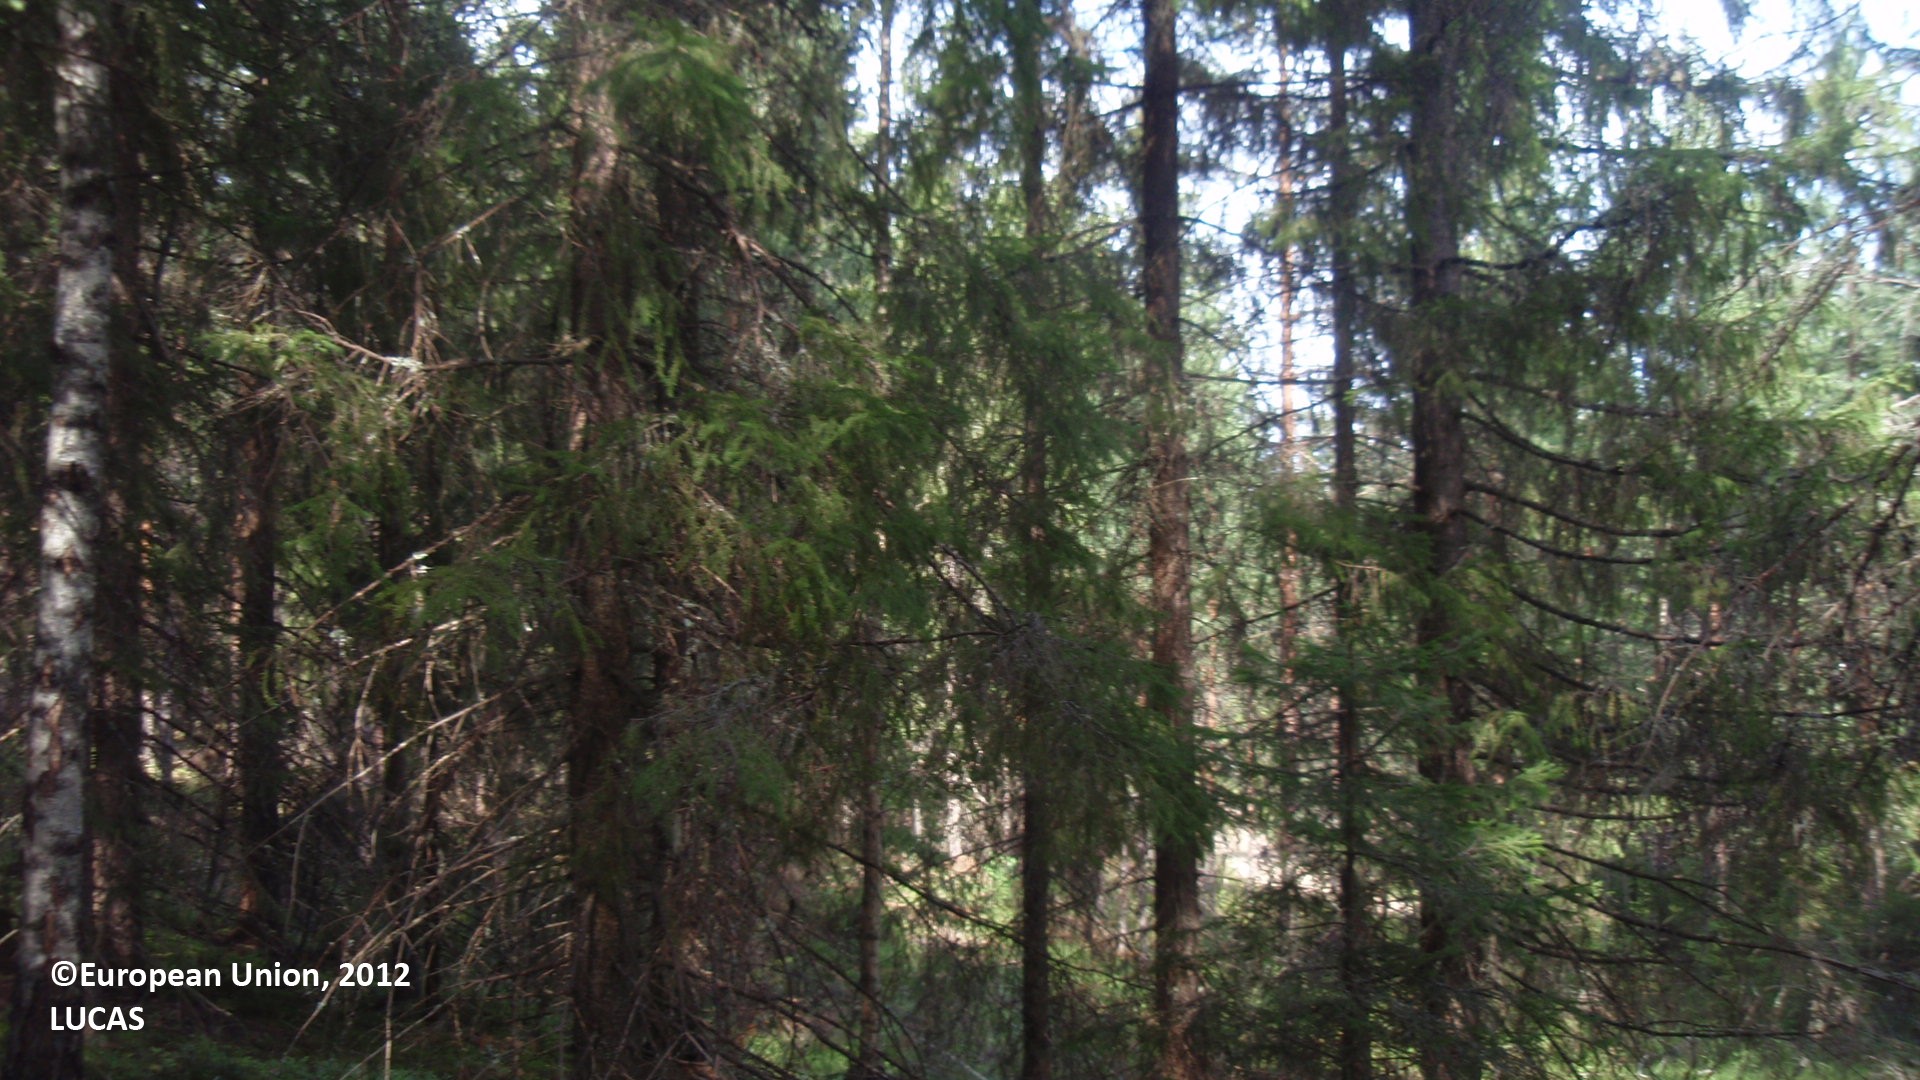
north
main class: Woodland
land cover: Spruce dominated coniferous woodland
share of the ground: 50 - 75 %
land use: Forestry
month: August
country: FI
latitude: 61.2027
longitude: 27.0449
